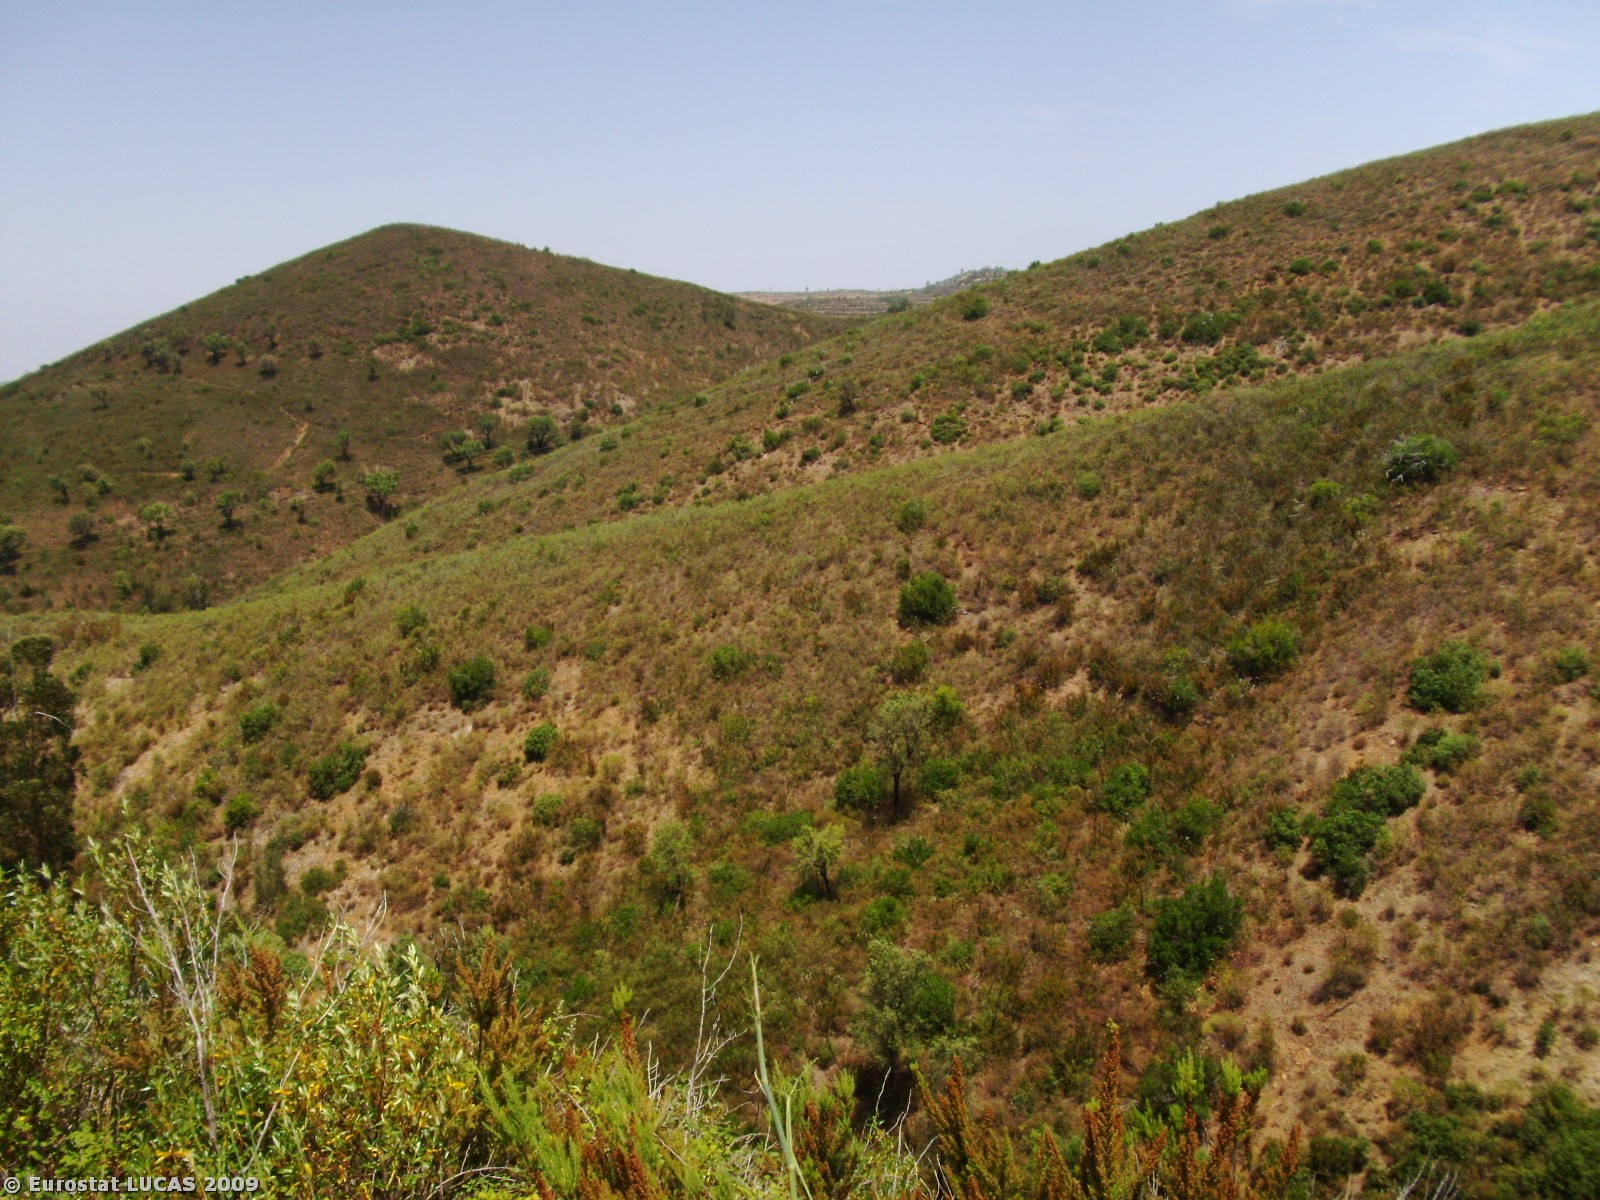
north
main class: Shrubland
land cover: Shrubland with sparse tree cover
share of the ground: > 75 %
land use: Nature reserves
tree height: < 5 m
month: June
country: PT
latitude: 37.3104
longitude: -8.7533
